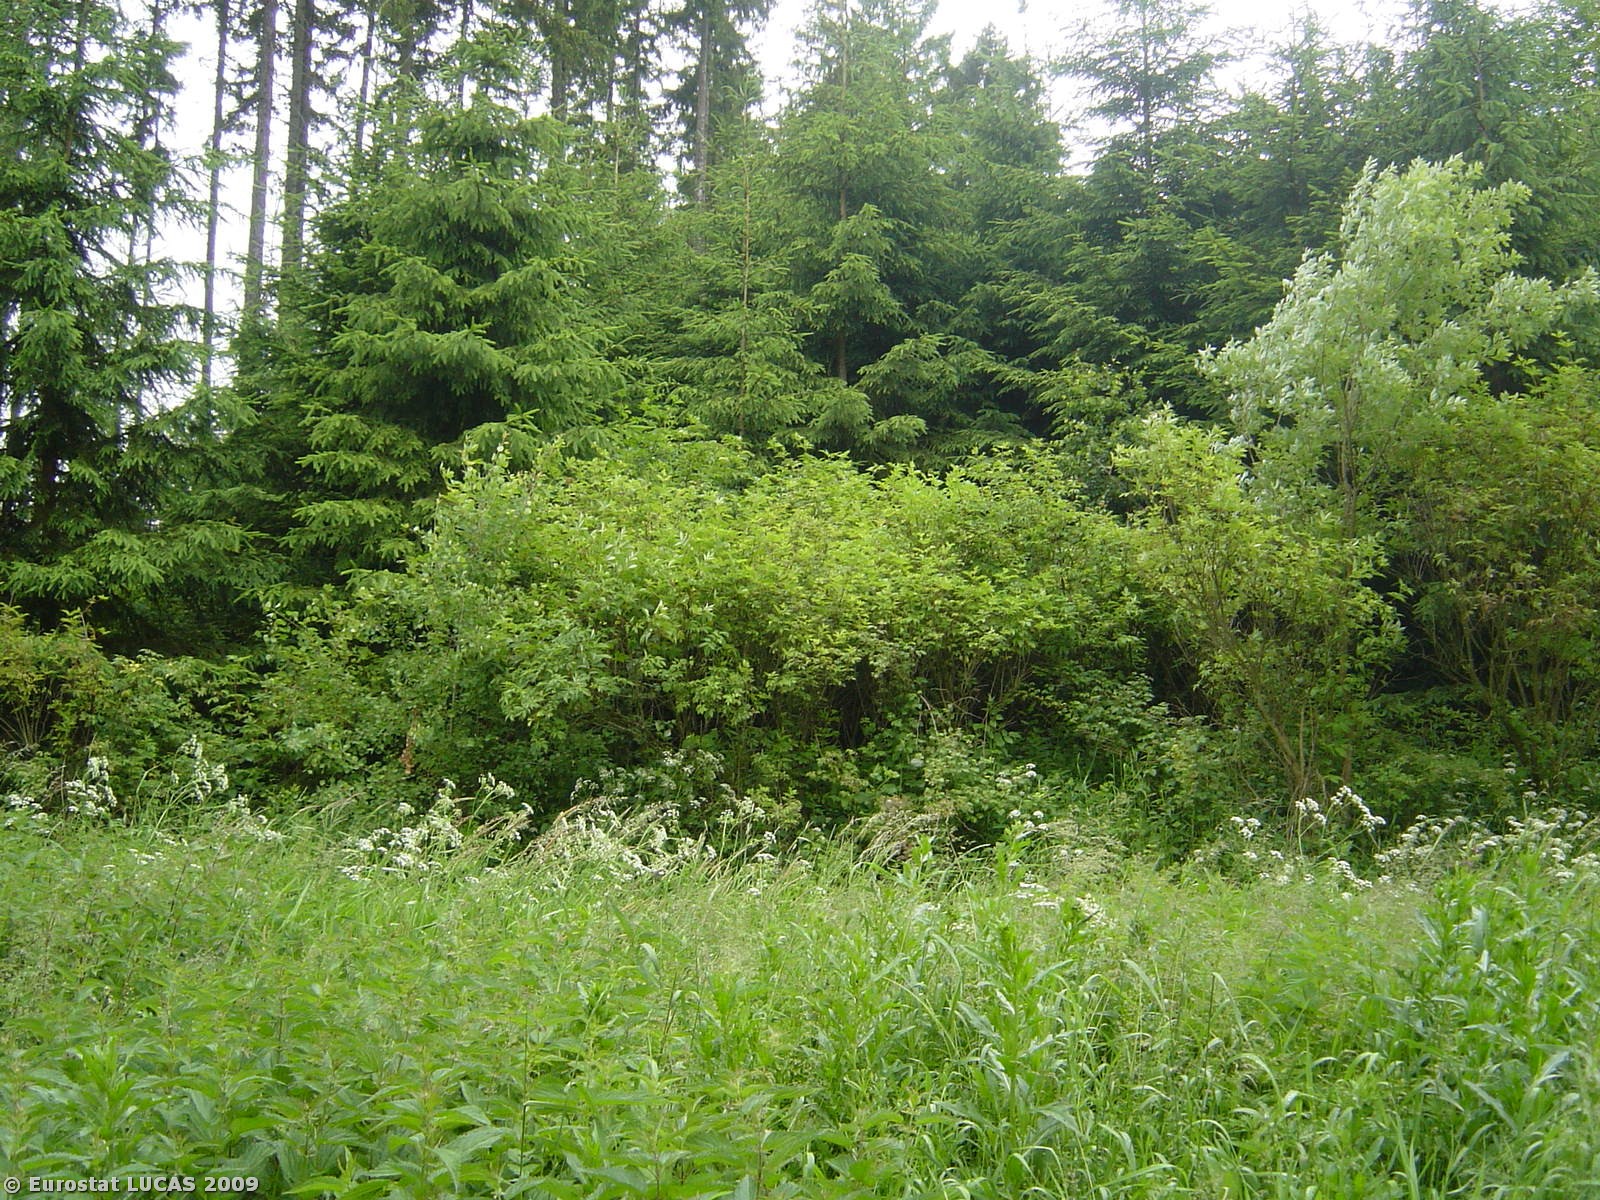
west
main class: Grassland
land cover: Grassland without tree/shrub cover
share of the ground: > 75 %
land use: Unused
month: June
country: CZ
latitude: 49.7273
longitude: 16.5136
